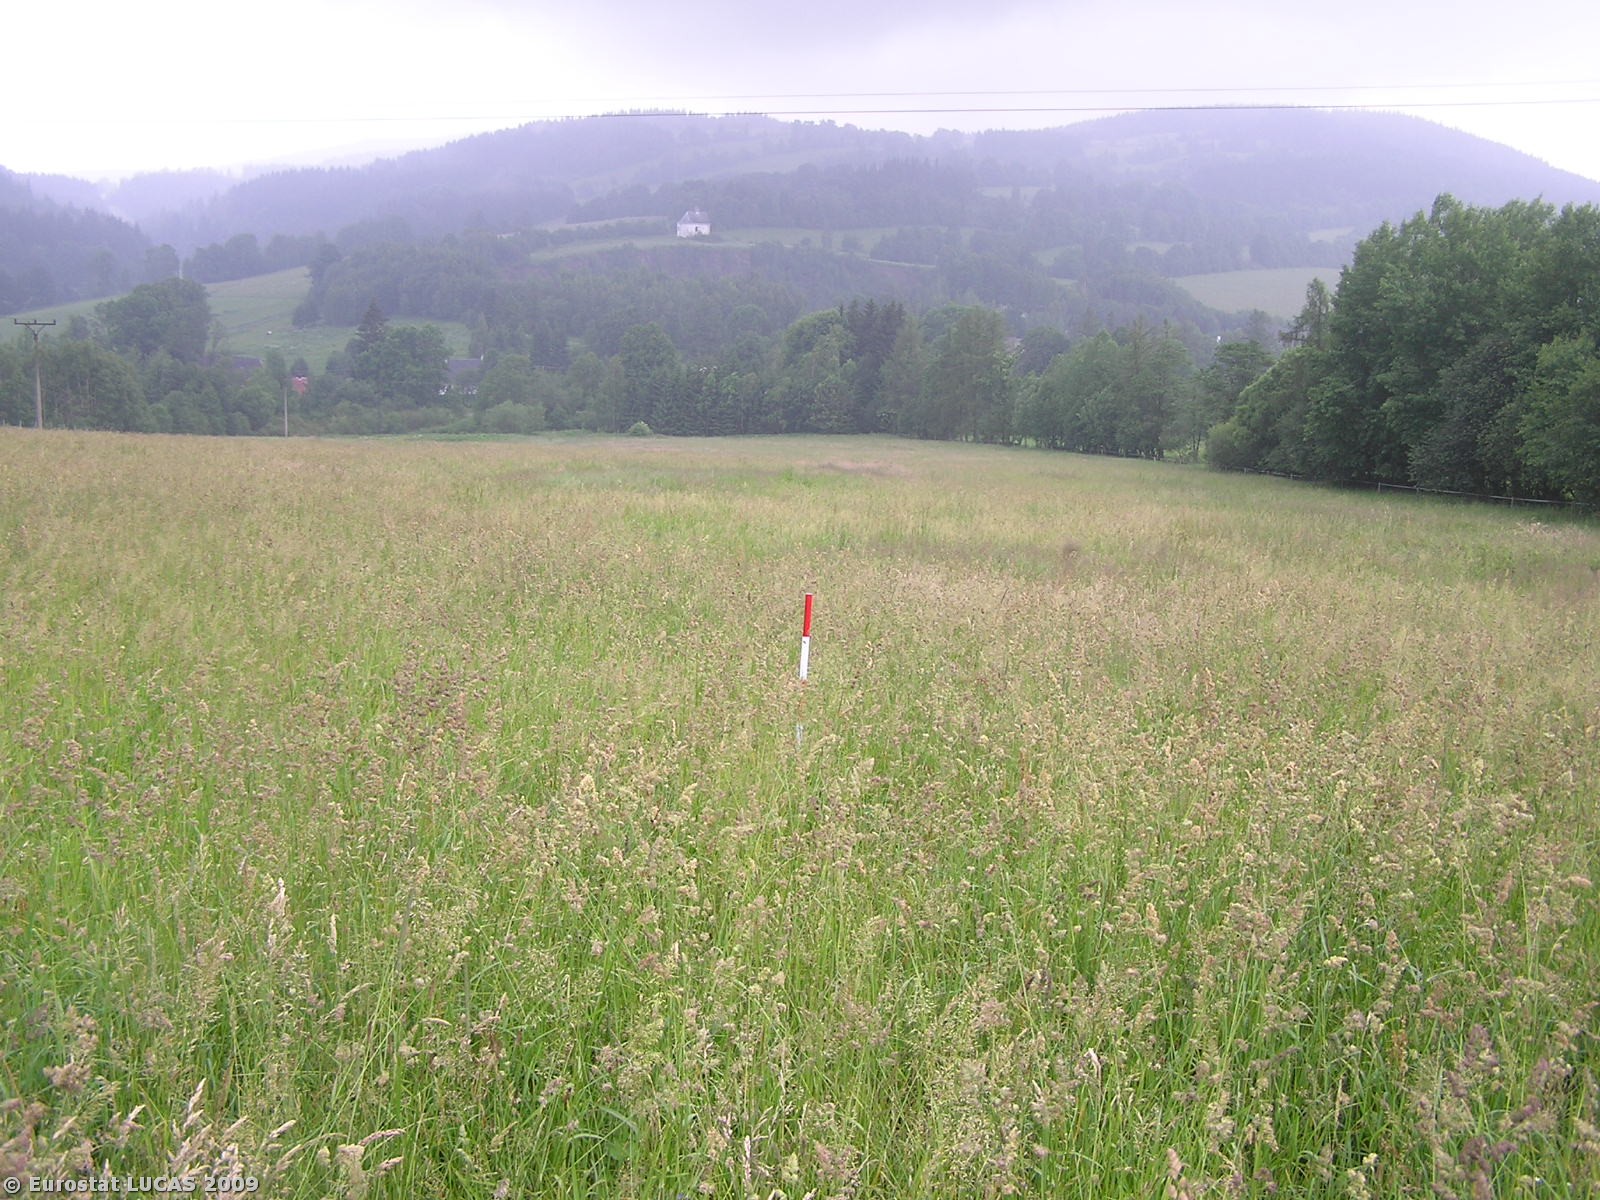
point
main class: Grassland
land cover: Grassland without tree/shrub cover
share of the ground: > 75 %
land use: Agriculture (excluding fallow land and kitchen gardens)
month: June
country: CZ
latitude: 50.1968
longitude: 17.3944
